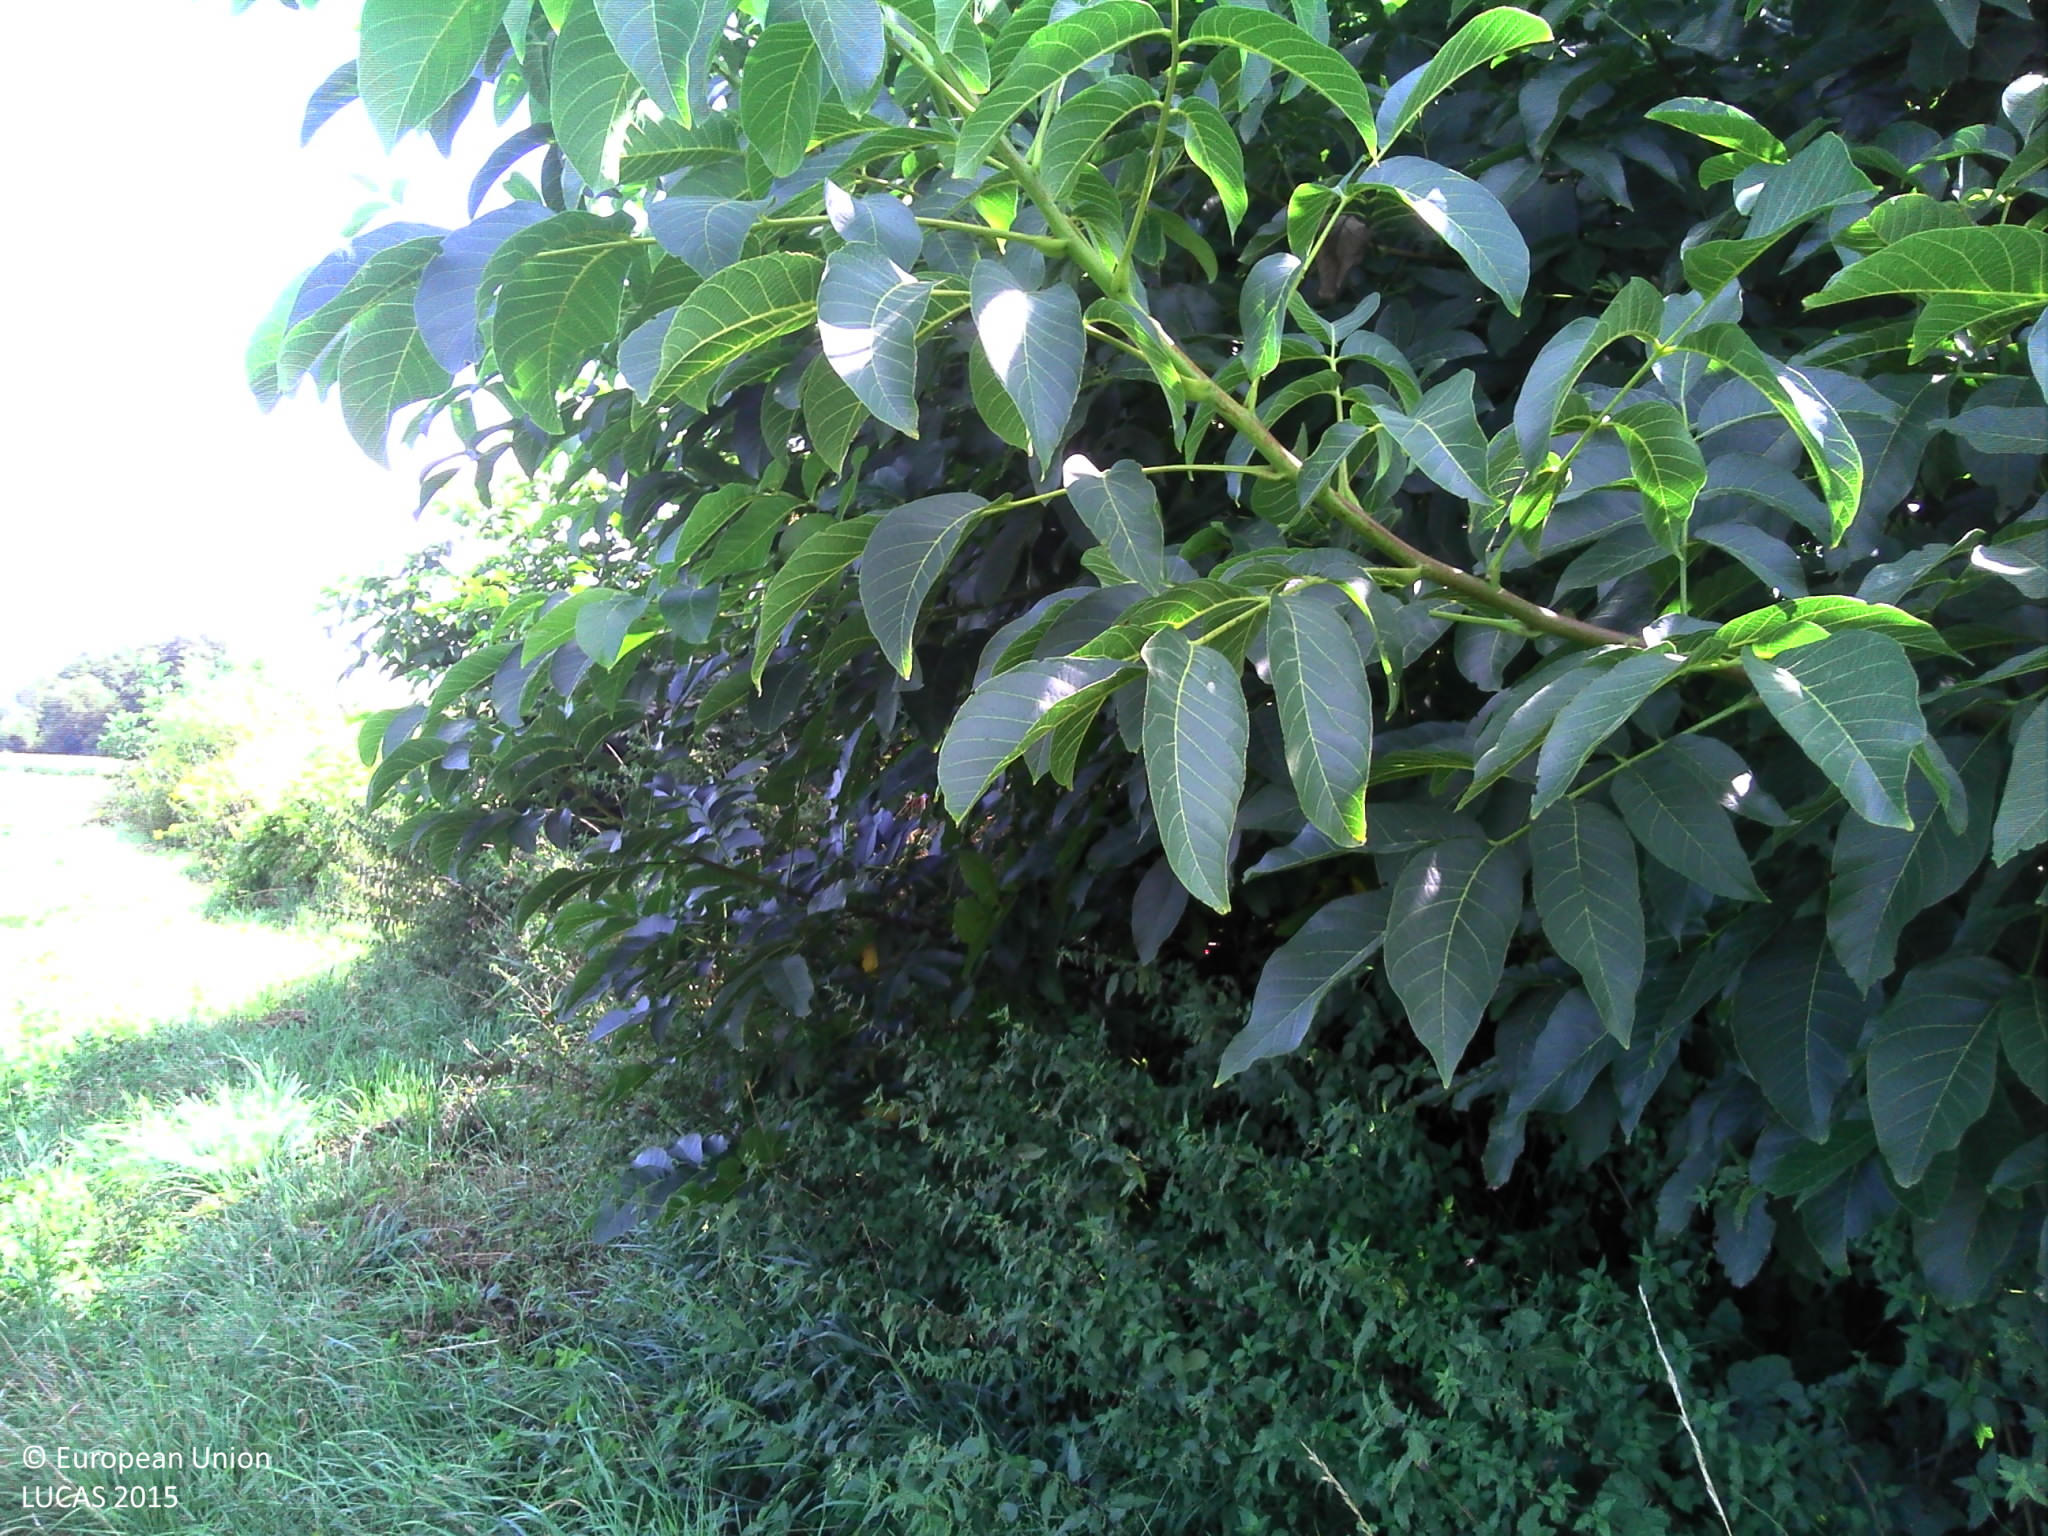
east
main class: Cropland
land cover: Sugar beet
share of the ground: > 75 %
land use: Agriculture (excluding fallow land and kitchen gardens)
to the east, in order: Grass margins; Abandoned hedges; Electric lines; Railways; Electric lines; Spontaneously vegetated surfaces; Tracks; Grassland without tree/shrub cover; Broadleaved woodland
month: August
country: FR
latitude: 48.7559
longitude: 7.6203
